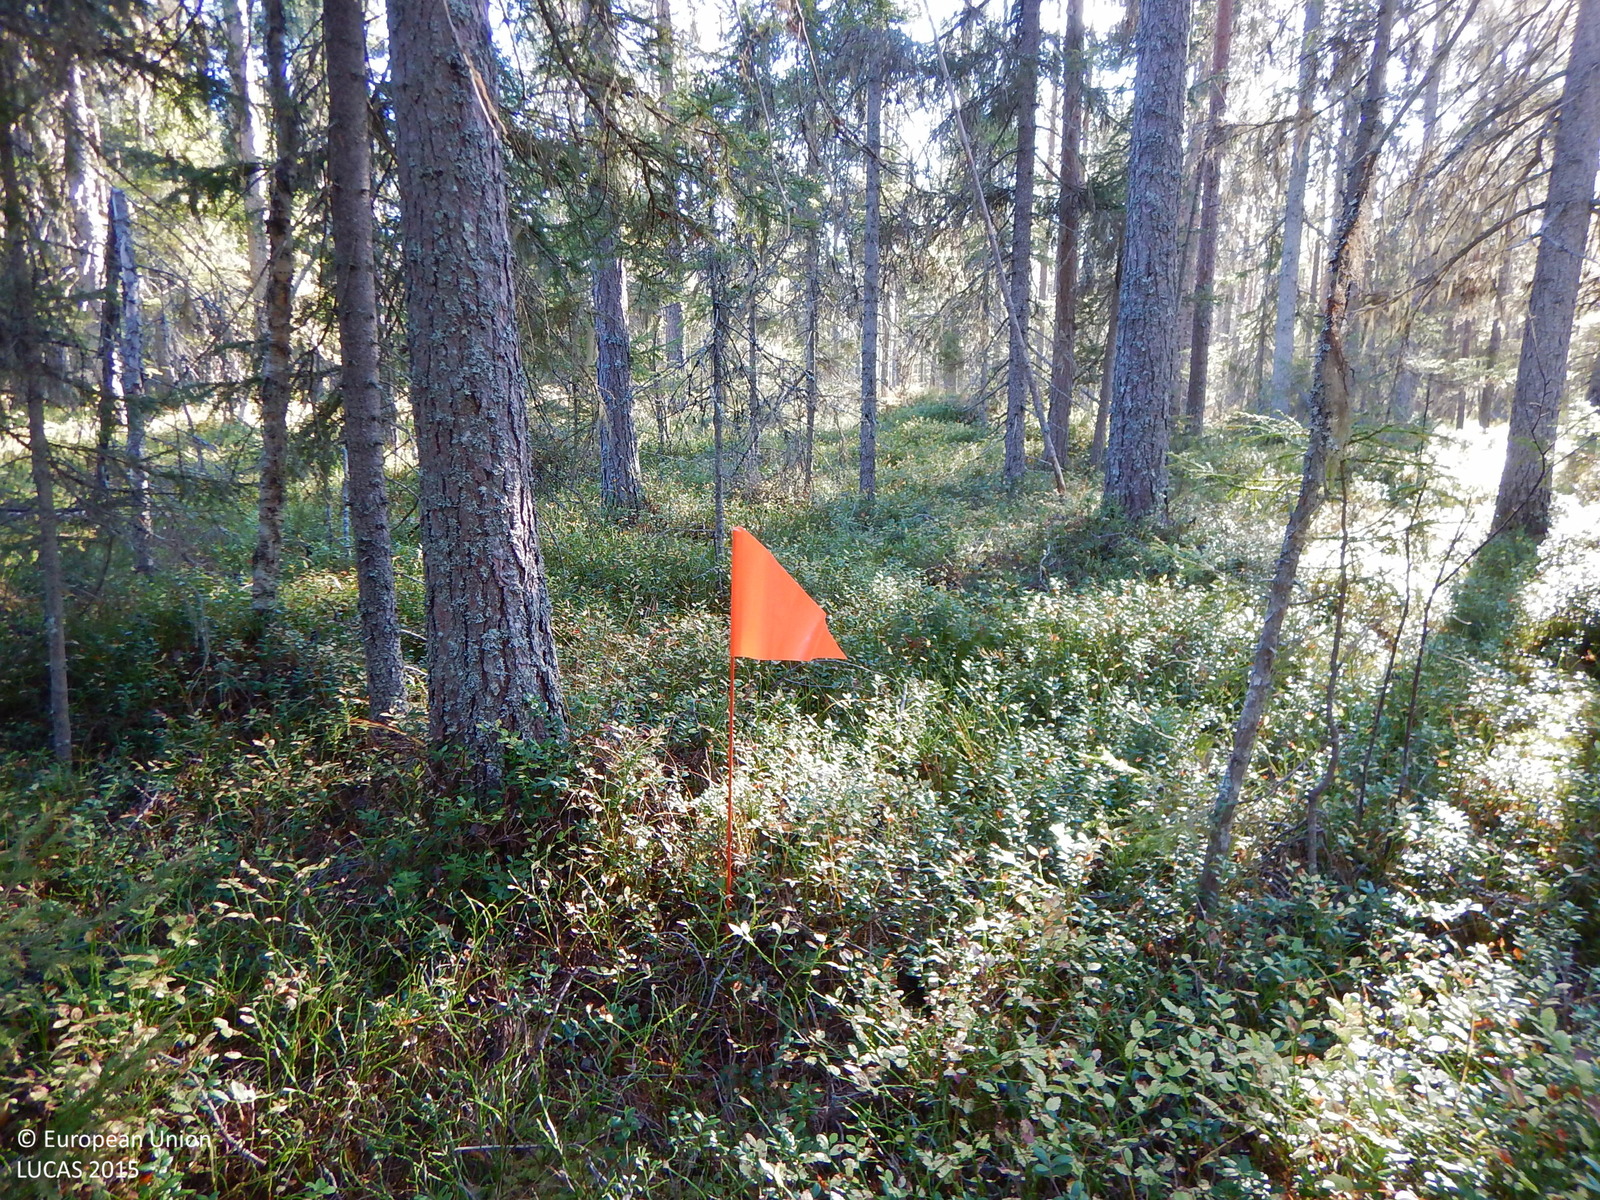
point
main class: Woodland
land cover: Other coniferous woodland
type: boreal forest
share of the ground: 50 - 75 %
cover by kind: coniferous forest trees 60 %, shrubs 15 %, lichens and mosses 15 %, herbaceous plants 10 %
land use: Forestry
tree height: > 5 m
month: October
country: SE
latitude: 64.9409
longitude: 21.0860
